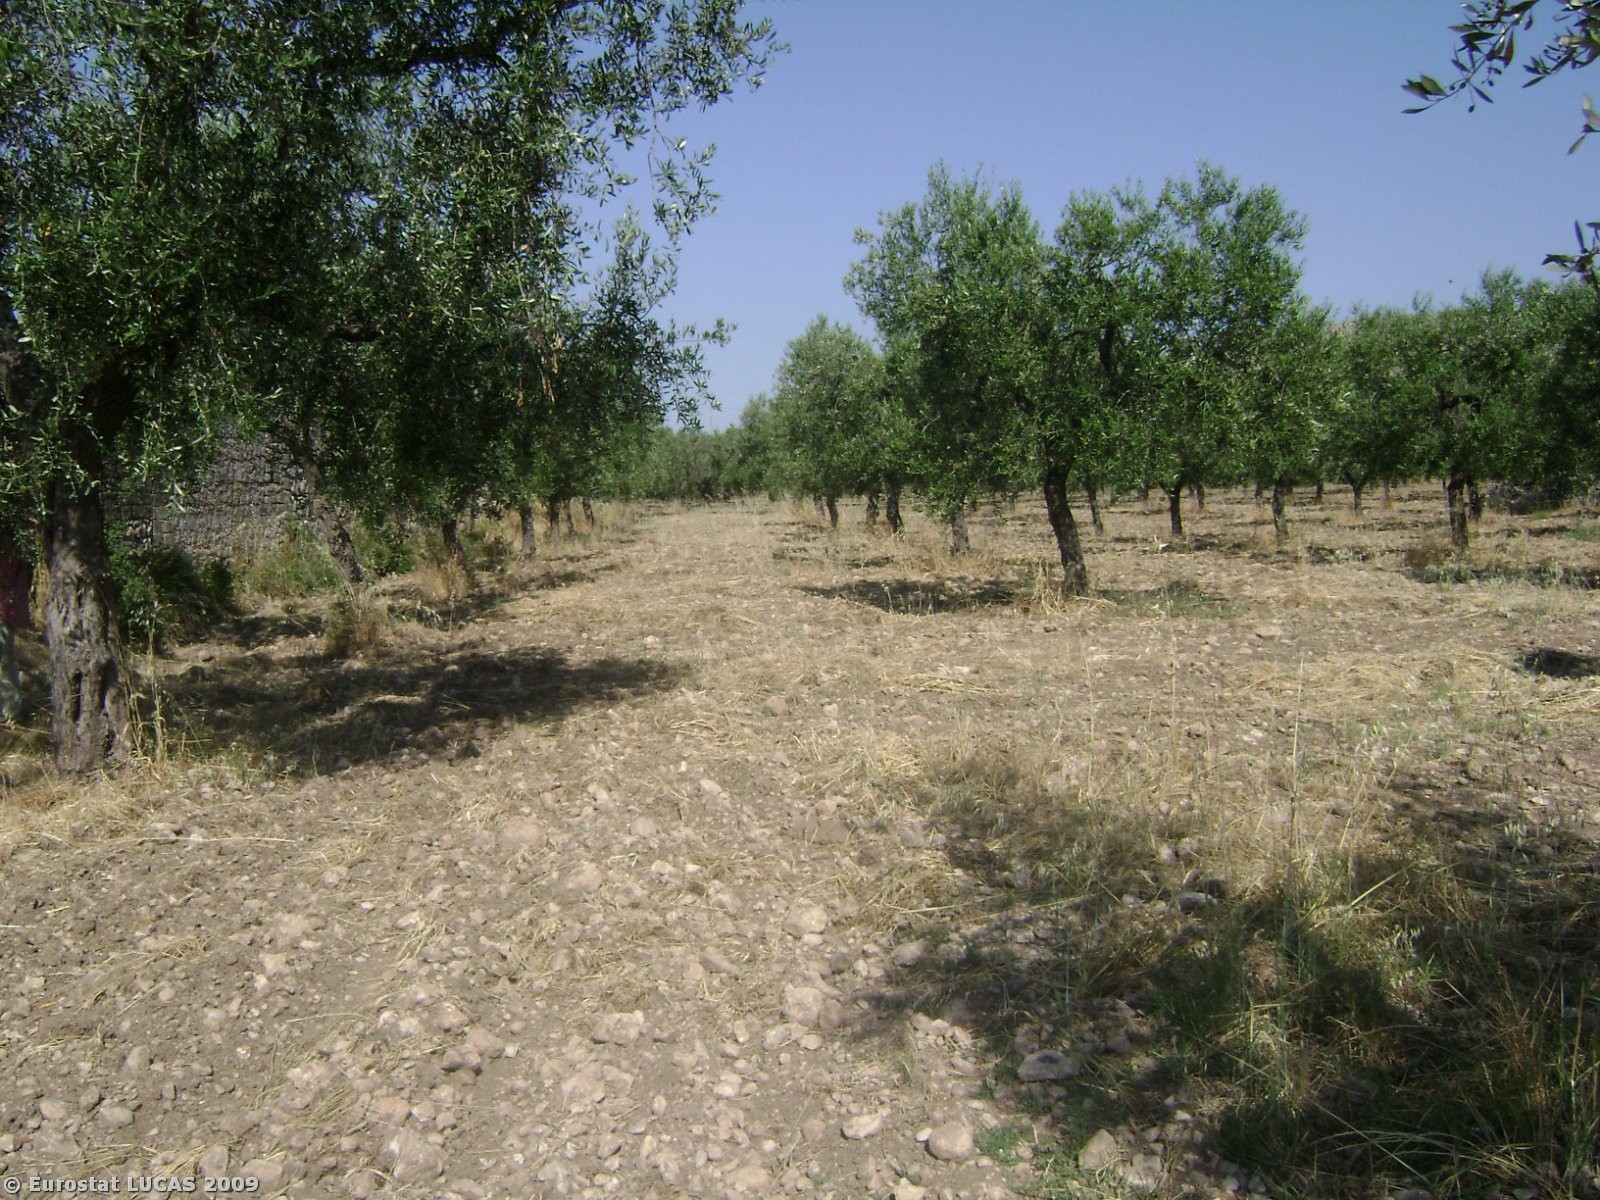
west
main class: Cropland
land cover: Olive groves
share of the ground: 50 - 75 %
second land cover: Bare land
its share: < 10 %
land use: Agriculture (excluding fallow land and kitchen gardens)
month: June
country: IT
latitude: 41.6488
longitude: 15.9019
